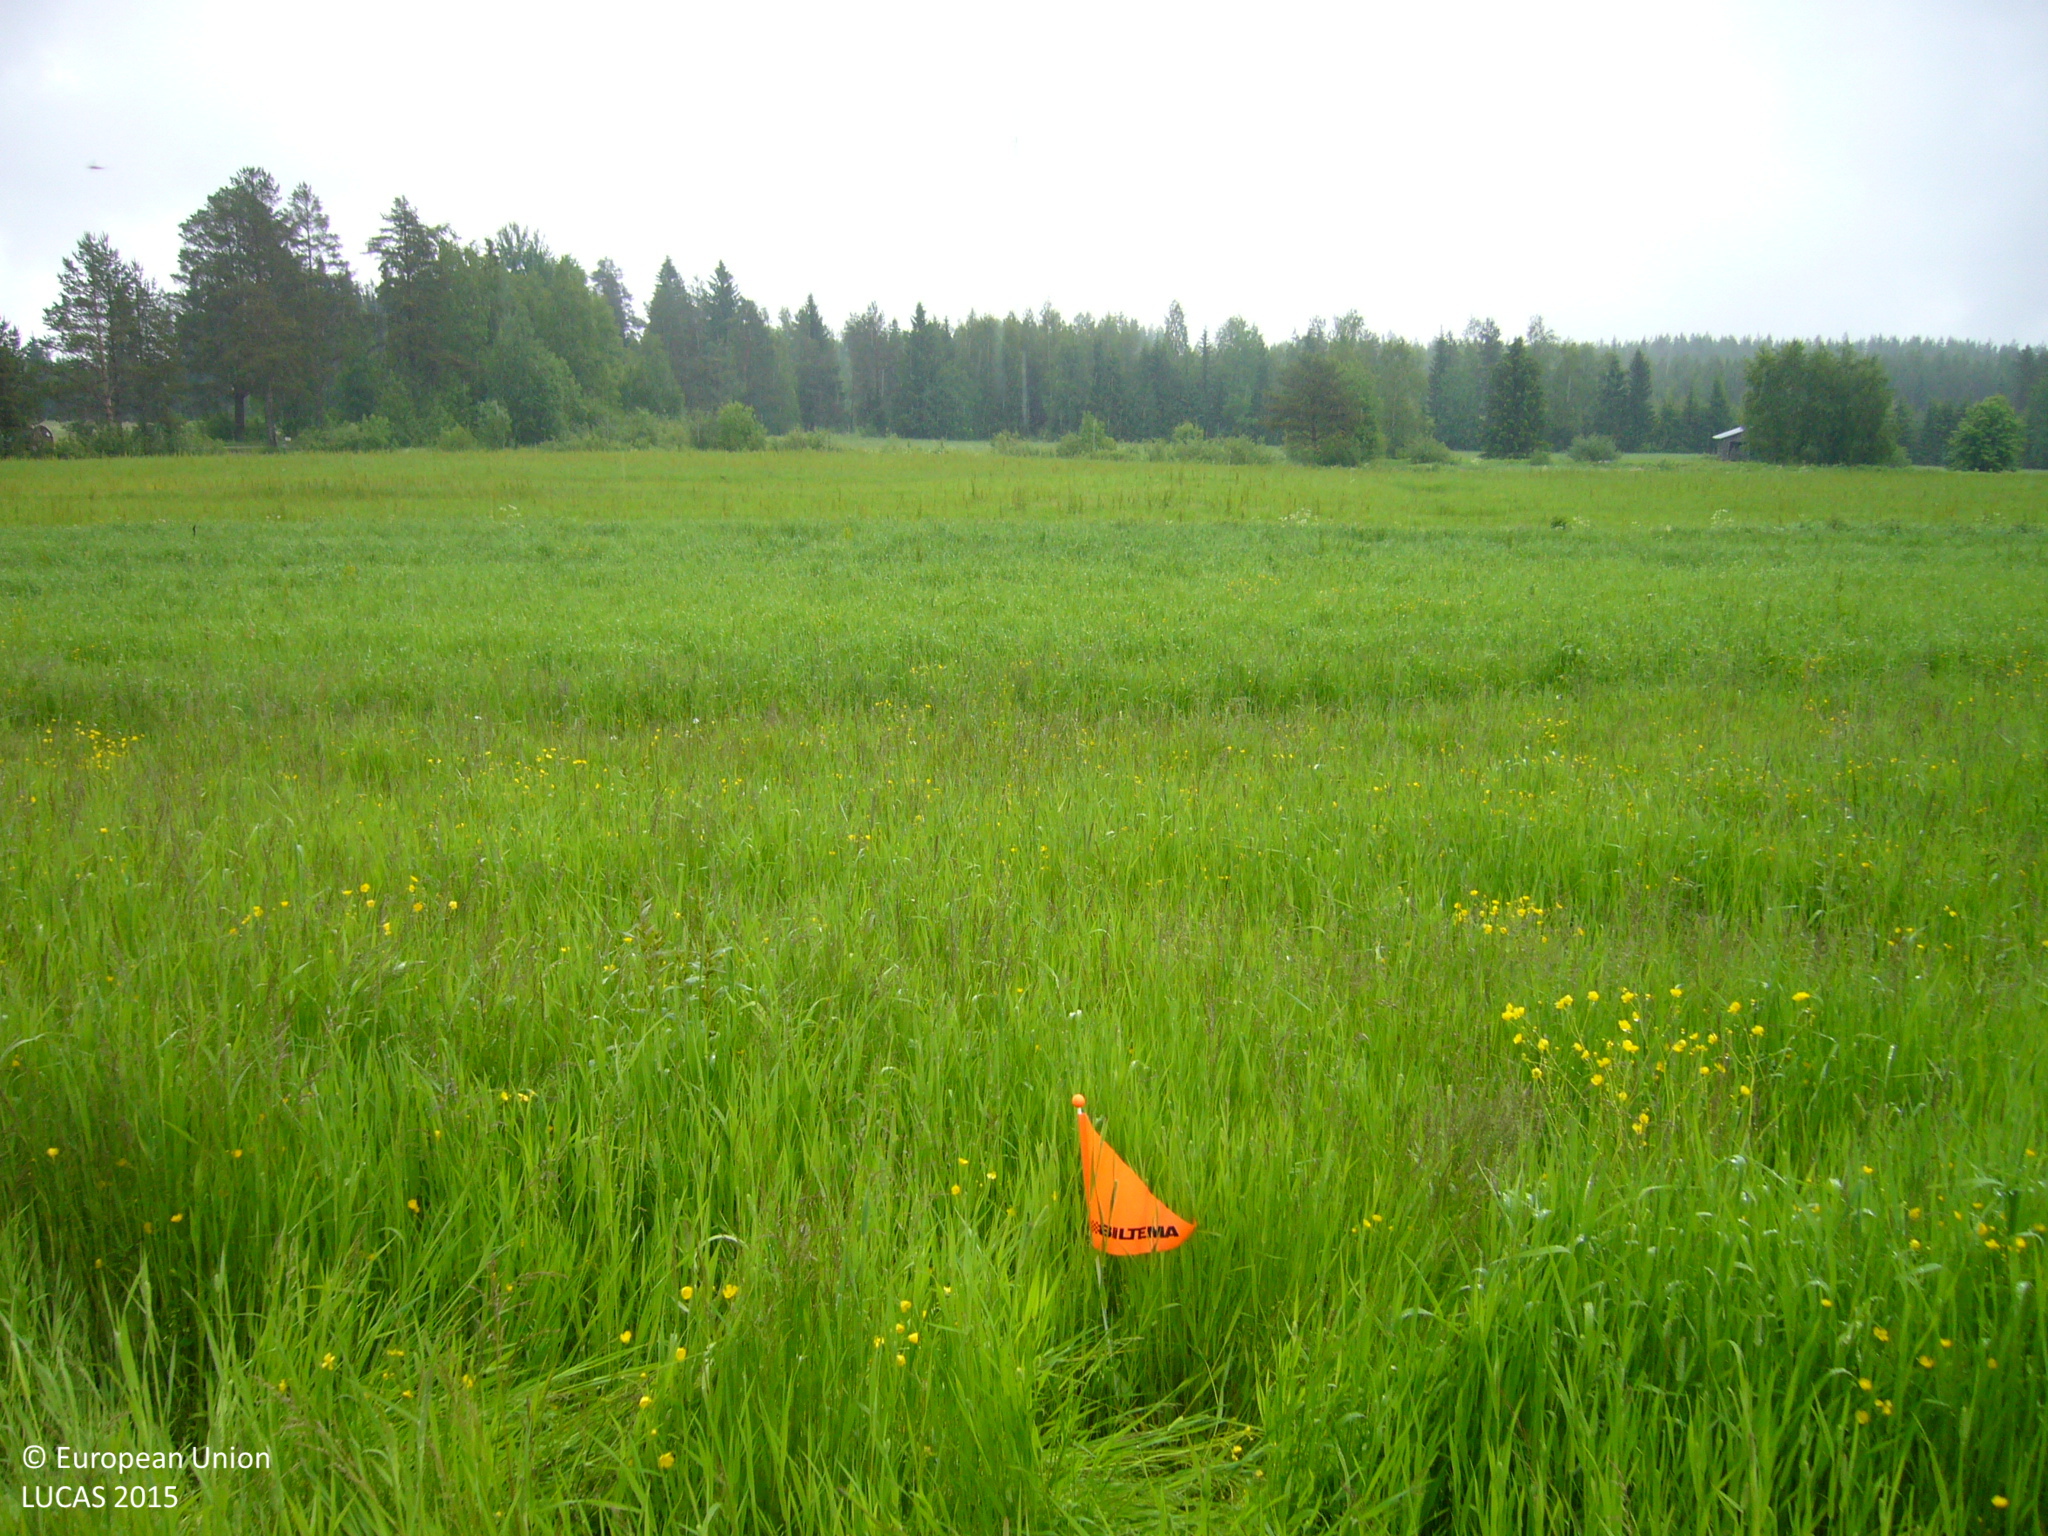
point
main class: Cropland
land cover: Temporary grasslands
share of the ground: > 75 %
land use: Agriculture (excluding fallow land and kitchen gardens)
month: June
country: FI
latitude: 63.6877
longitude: 26.1917
